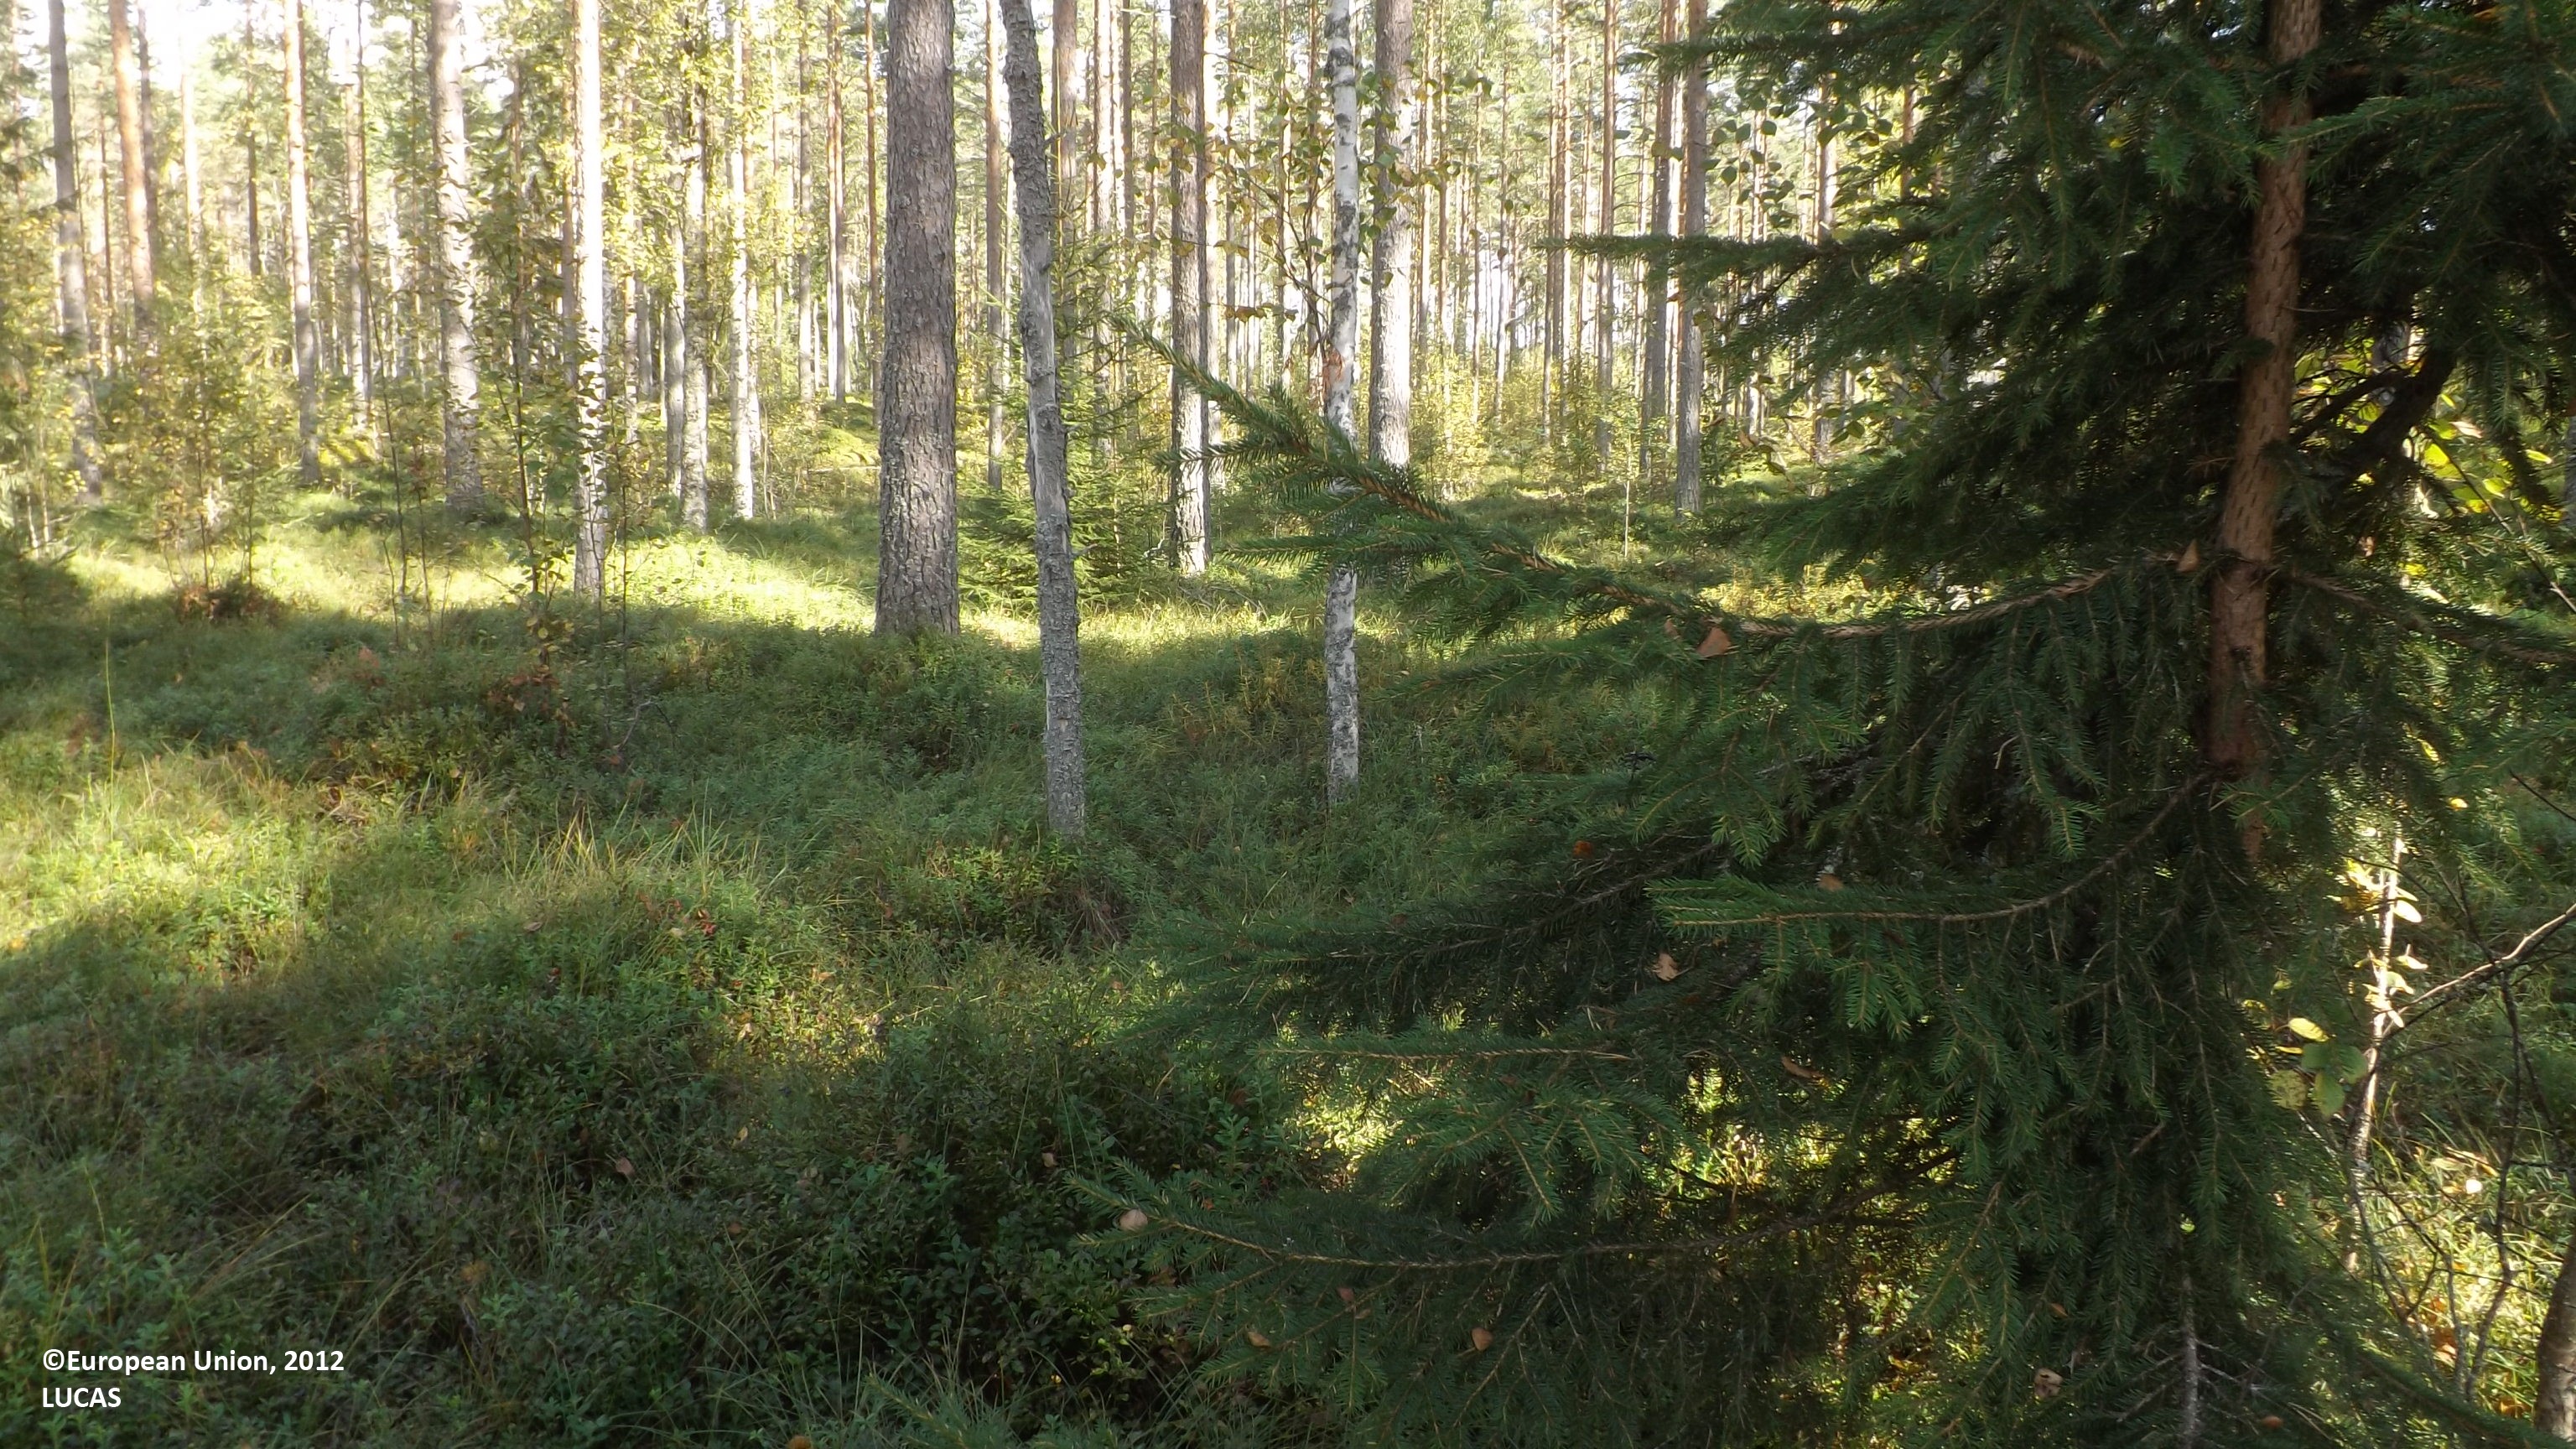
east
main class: Woodland
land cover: Pine dominated mixed woodland
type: boreal forest
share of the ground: 50 - 75 %
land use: Forestry
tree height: > 5 m
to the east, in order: Pine dominated mixed woodland; Other mixed woodland
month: August
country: FI
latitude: 63.9076
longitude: 23.7358
